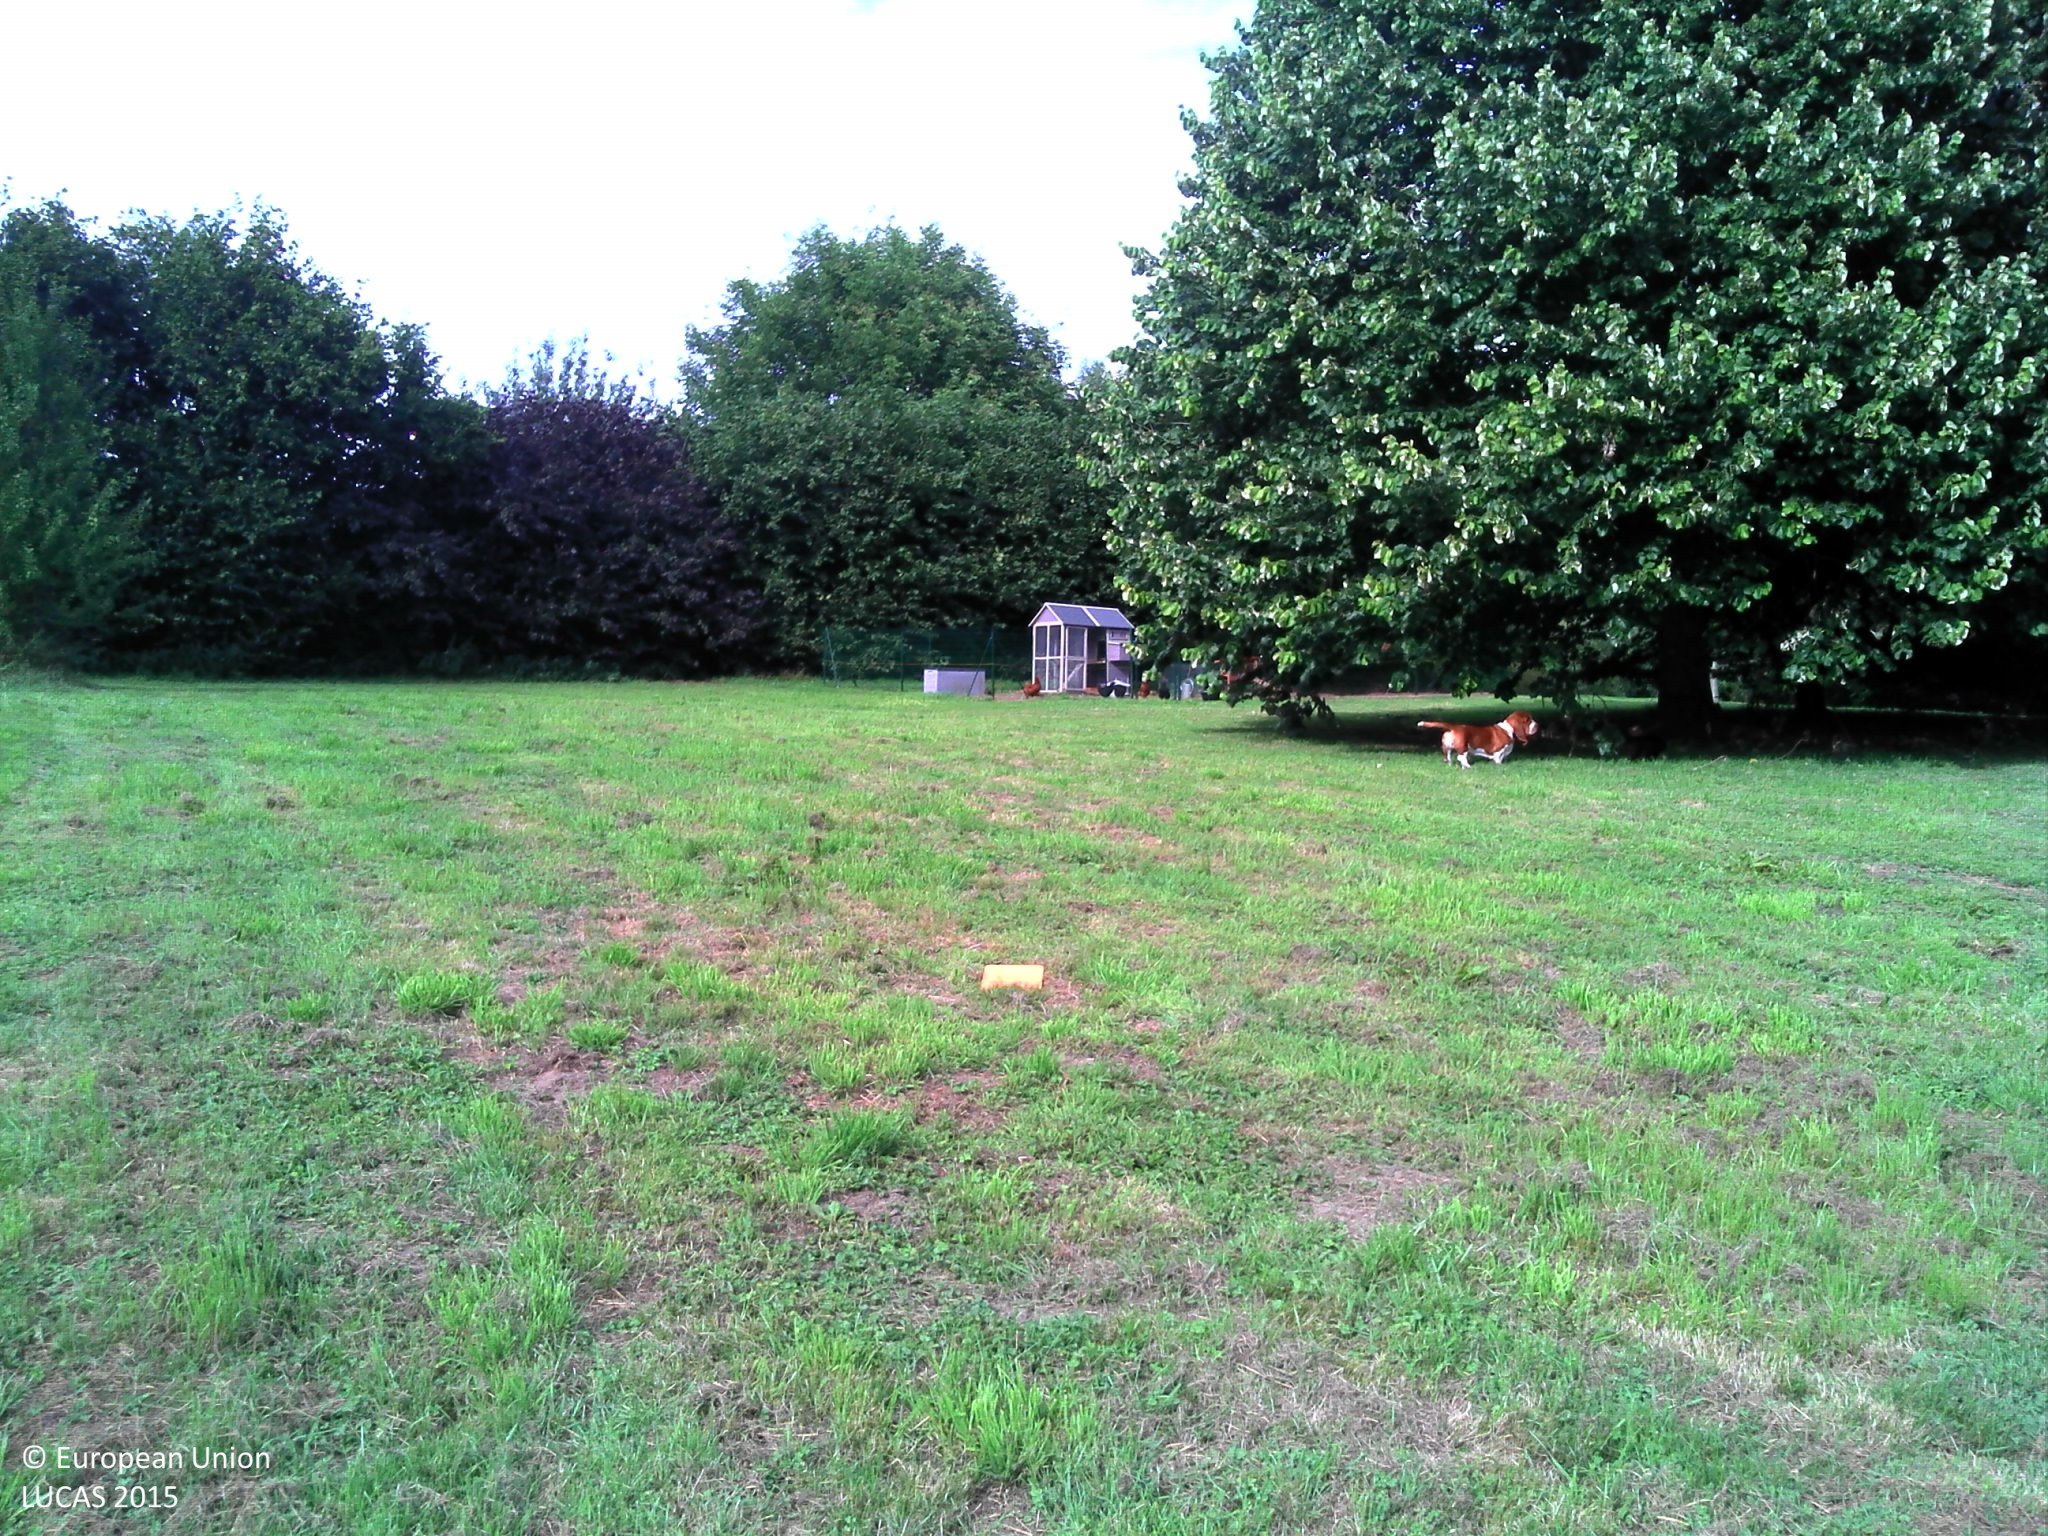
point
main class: Grassland
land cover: Grassland with sparse tree/shrub cover
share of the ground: > 75 %
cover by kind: herbaceous plants 95 %, broadleaved forest trees 5 %
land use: Residential
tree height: > 5 m
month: August
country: FR
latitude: 48.6701
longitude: -1.3572
